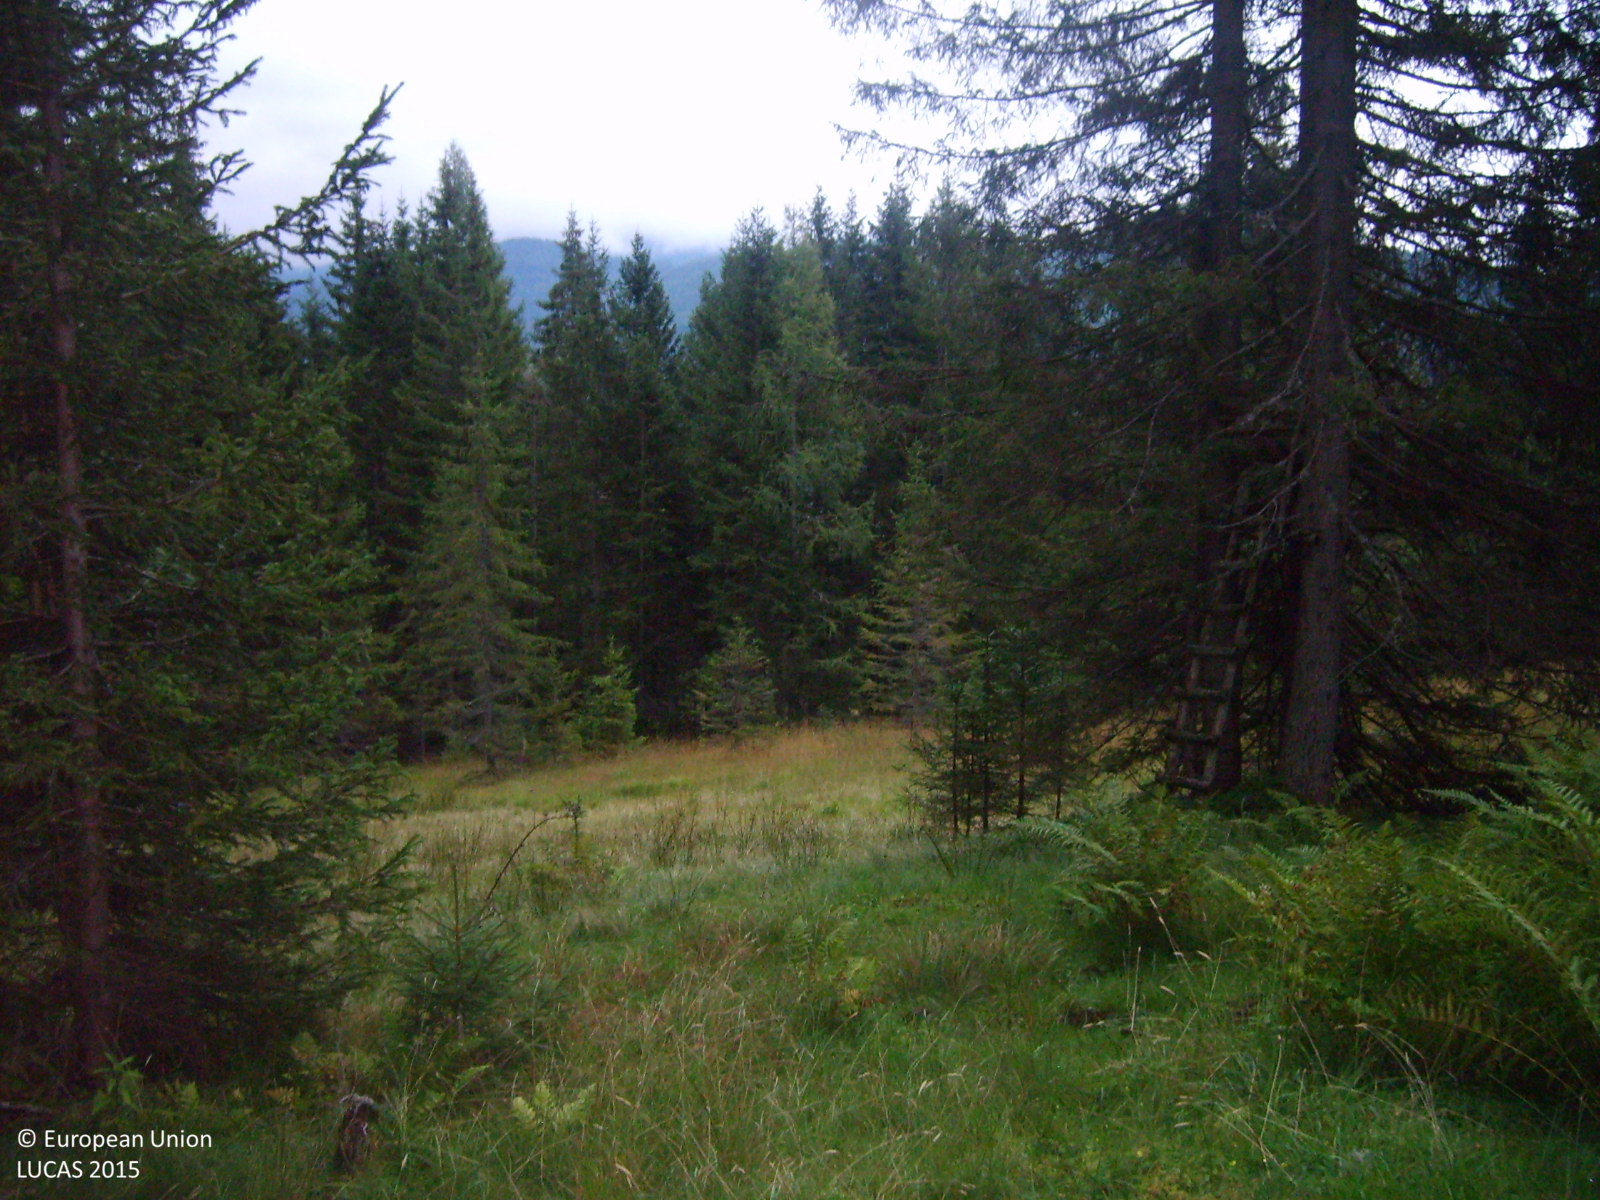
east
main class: Woodland
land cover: Spruce dominated coniferous woodland
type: alpine coniferous forest
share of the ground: 50 - 75 %
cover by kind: coniferous forest trees 55 %, shrubs 35 %, lichens and mosses 10 %
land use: Forestry
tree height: > 5 m
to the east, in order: Spruce dominated coniferous woodland; Grassland with sparse tree/shrub cover; Spruce dominated coniferous woodland; Grassland with sparse tree/shrub cover; Inland marshes; Fences; Ditches and canals; Grassland without tree/shrub cover
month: September
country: AT
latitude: 47.4487
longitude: 13.4598
